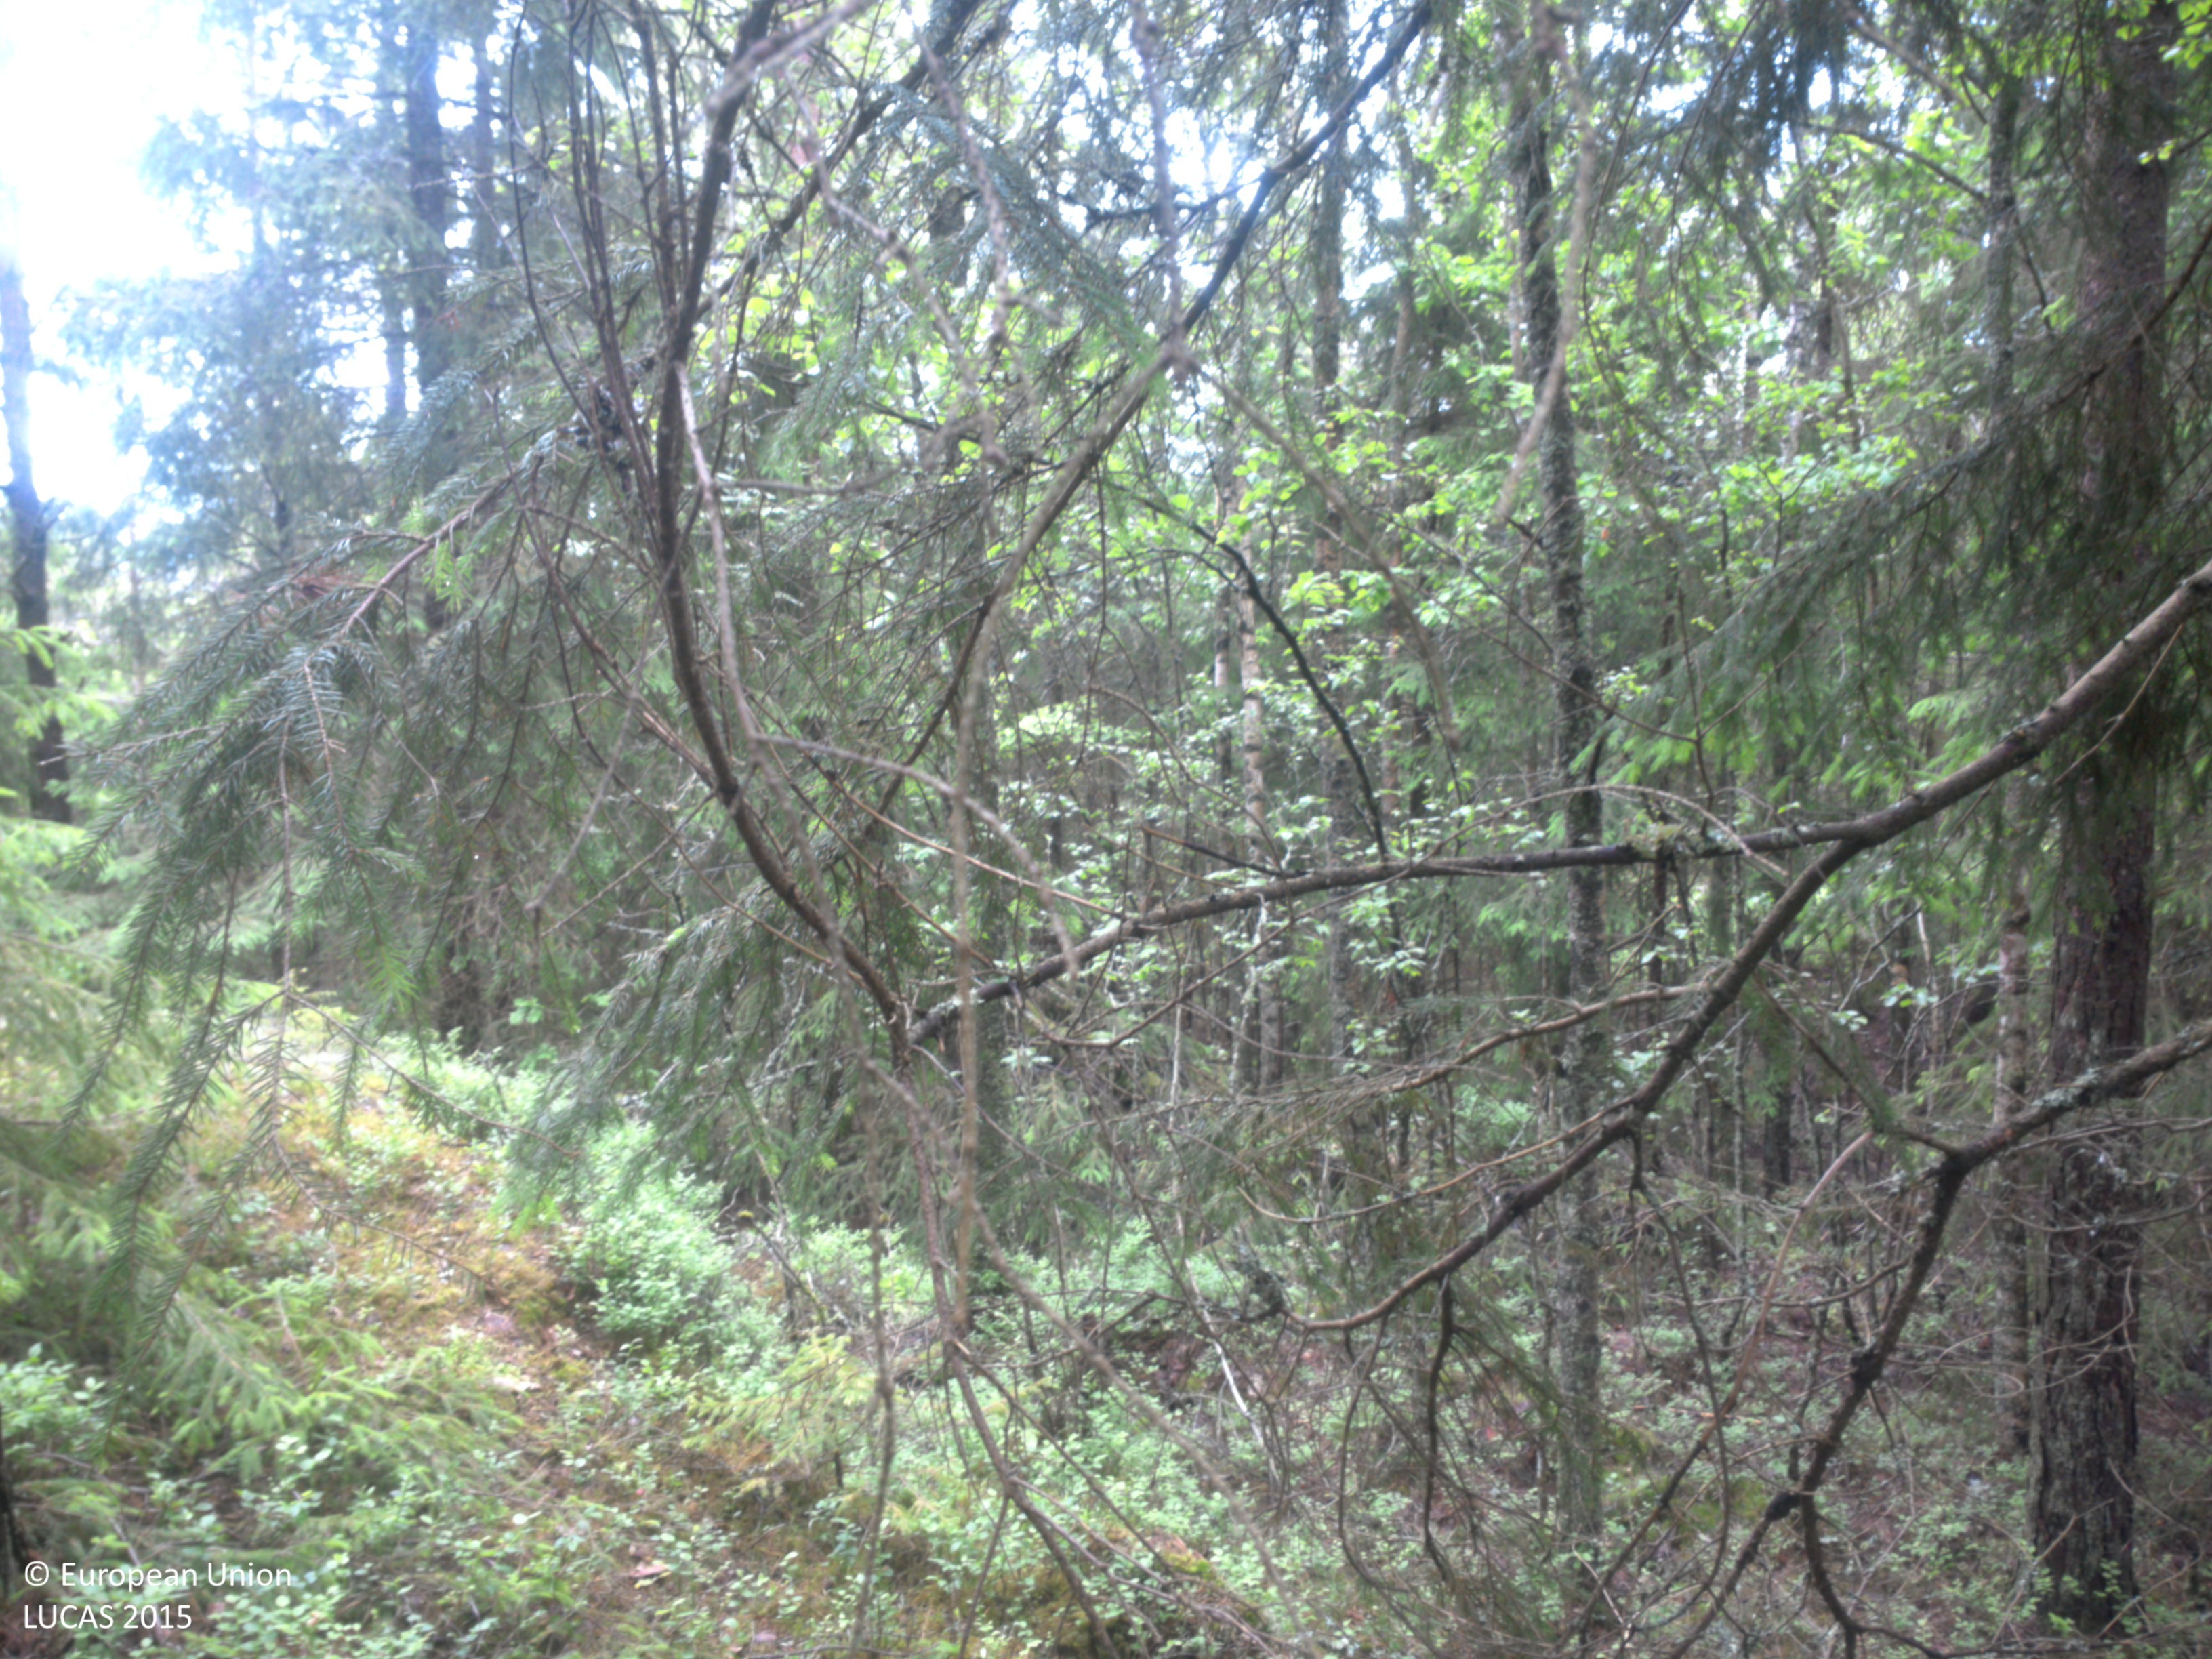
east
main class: Woodland
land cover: Spruce dominated coniferous woodland
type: boreal forest
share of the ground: 50 - 75 %
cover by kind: coniferous forest trees 50 %, lichens and mosses 40 %, broadleaved forest trees 5 %, shrubs 5 %
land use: Forestry
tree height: > 5 m
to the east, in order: Spruce dominated coniferous woodland; Spruce dominated mixed woodland; Spruce dominated coniferous woodland
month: June
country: SE
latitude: 58.4773
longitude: 11.7968
